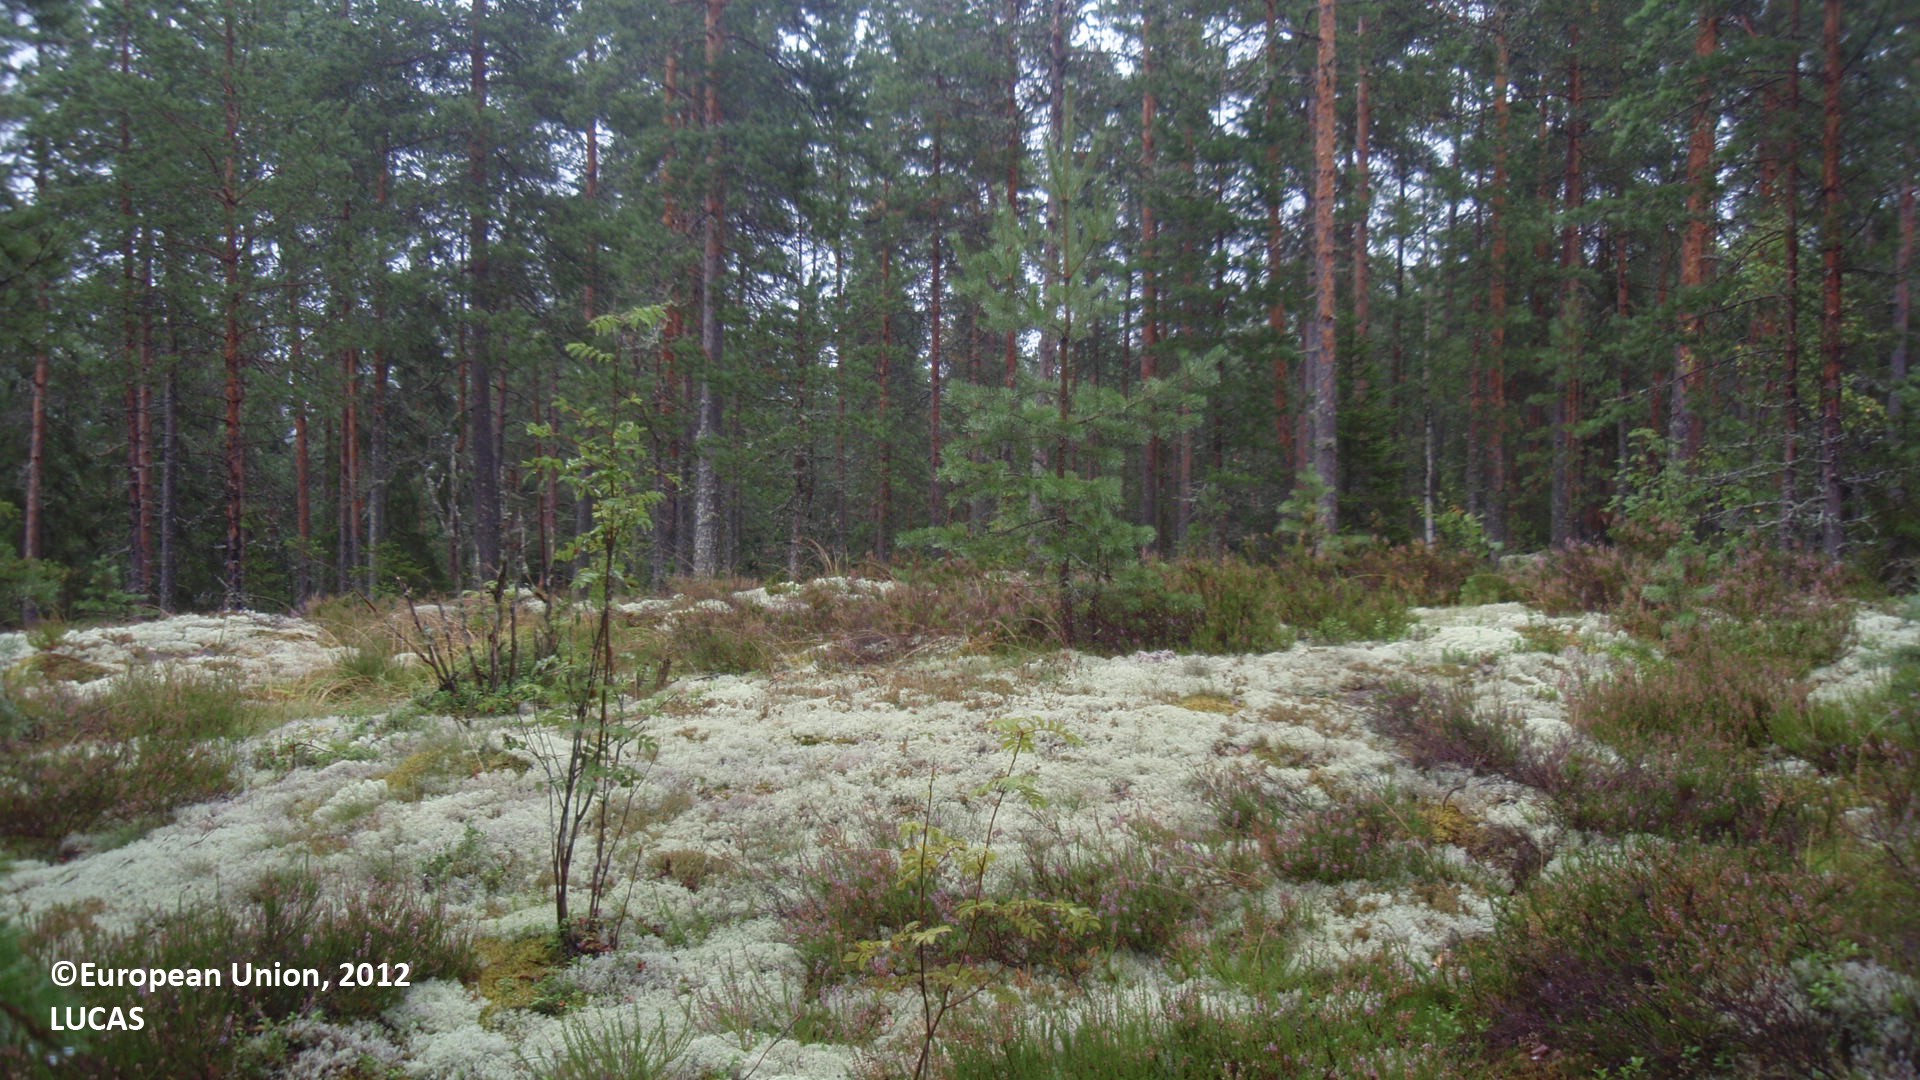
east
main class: Woodland
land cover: Pine dominated mixed woodland
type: boreal forest
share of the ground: 50 - 75 %
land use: Forestry
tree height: > 5 m
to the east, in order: Pine dominated mixed woodland; Lichens and moss; Pine dominated coniferous woodland; Spruce dominated coniferous woodland; Paved roads, cycling and walking lanes; Lines of trees; Ditches and canals; Oats
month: August
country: FI
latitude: 60.8547
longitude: 26.8586
